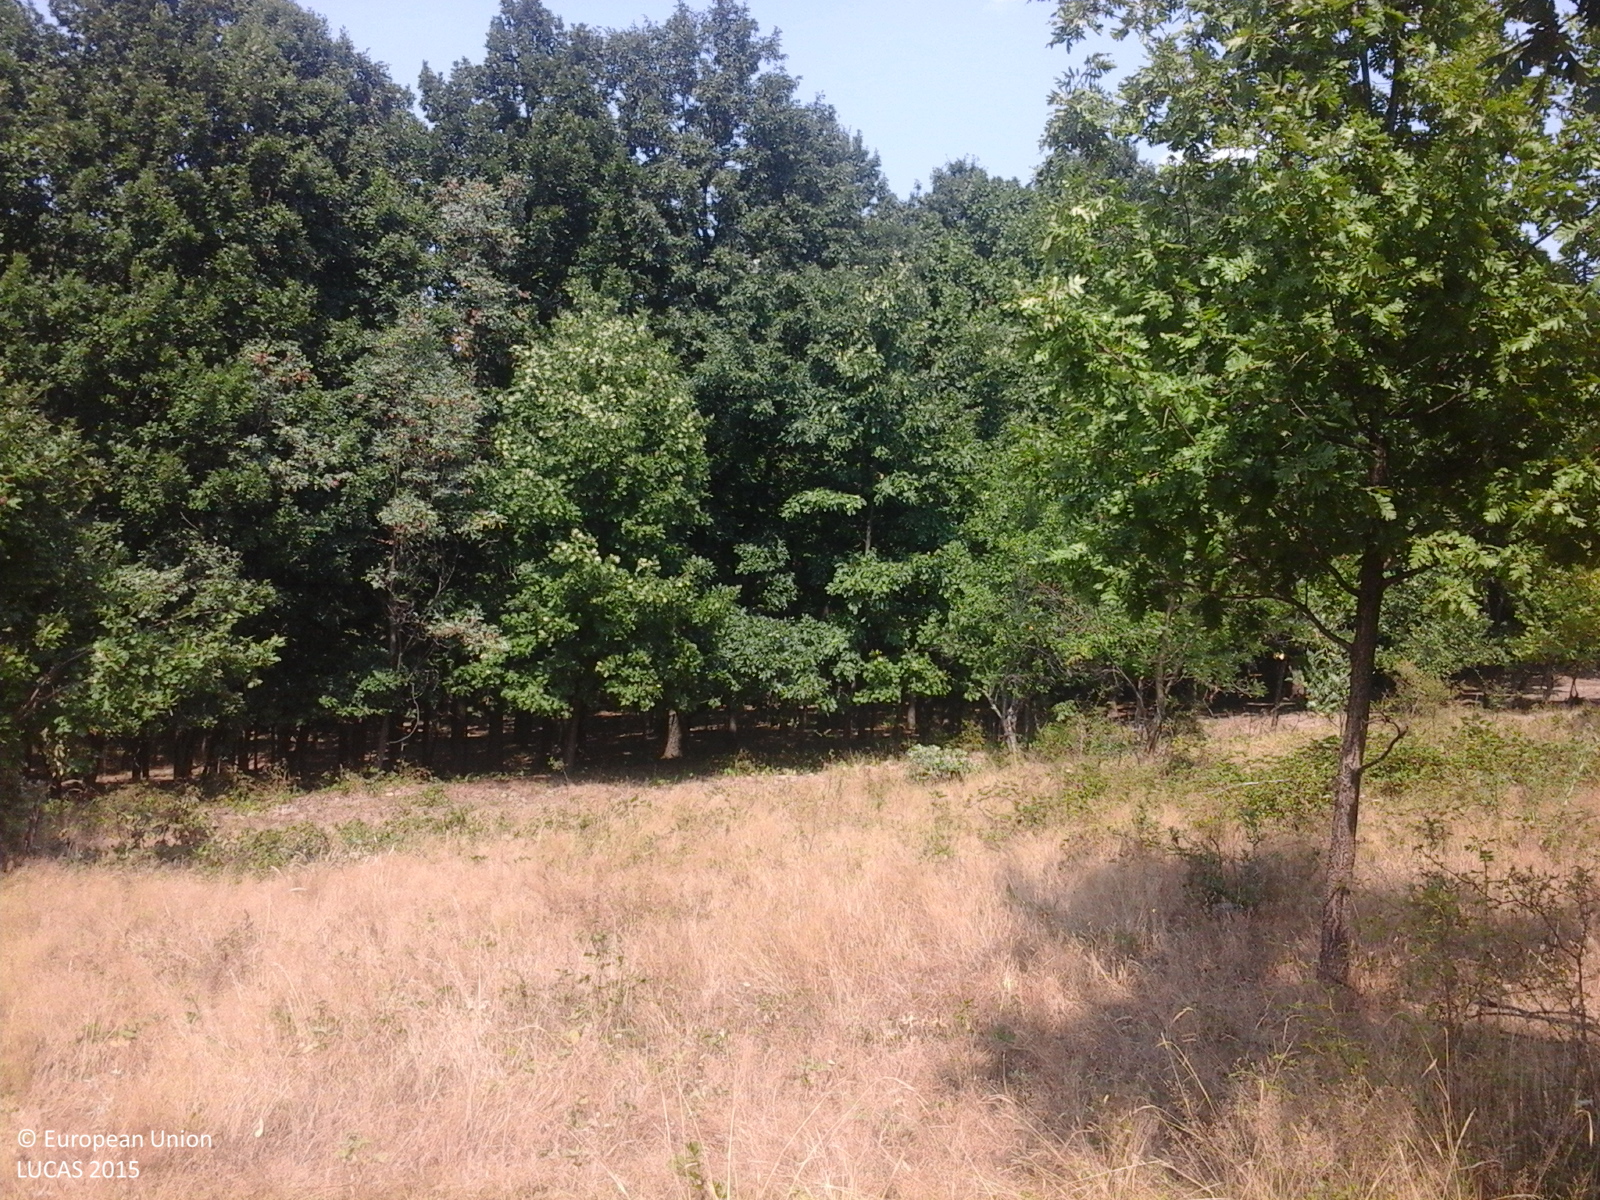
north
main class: Grassland
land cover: Grassland with sparse tree/shrub cover
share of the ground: > 75 %
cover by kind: herbaceous plants 85 %, shrubs 10 %, broadleaved forest trees 5 %
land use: Agriculture (excluding fallow land and kitchen gardens)
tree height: > 5 m
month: August
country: RO
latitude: 44.6009
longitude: 23.0361
